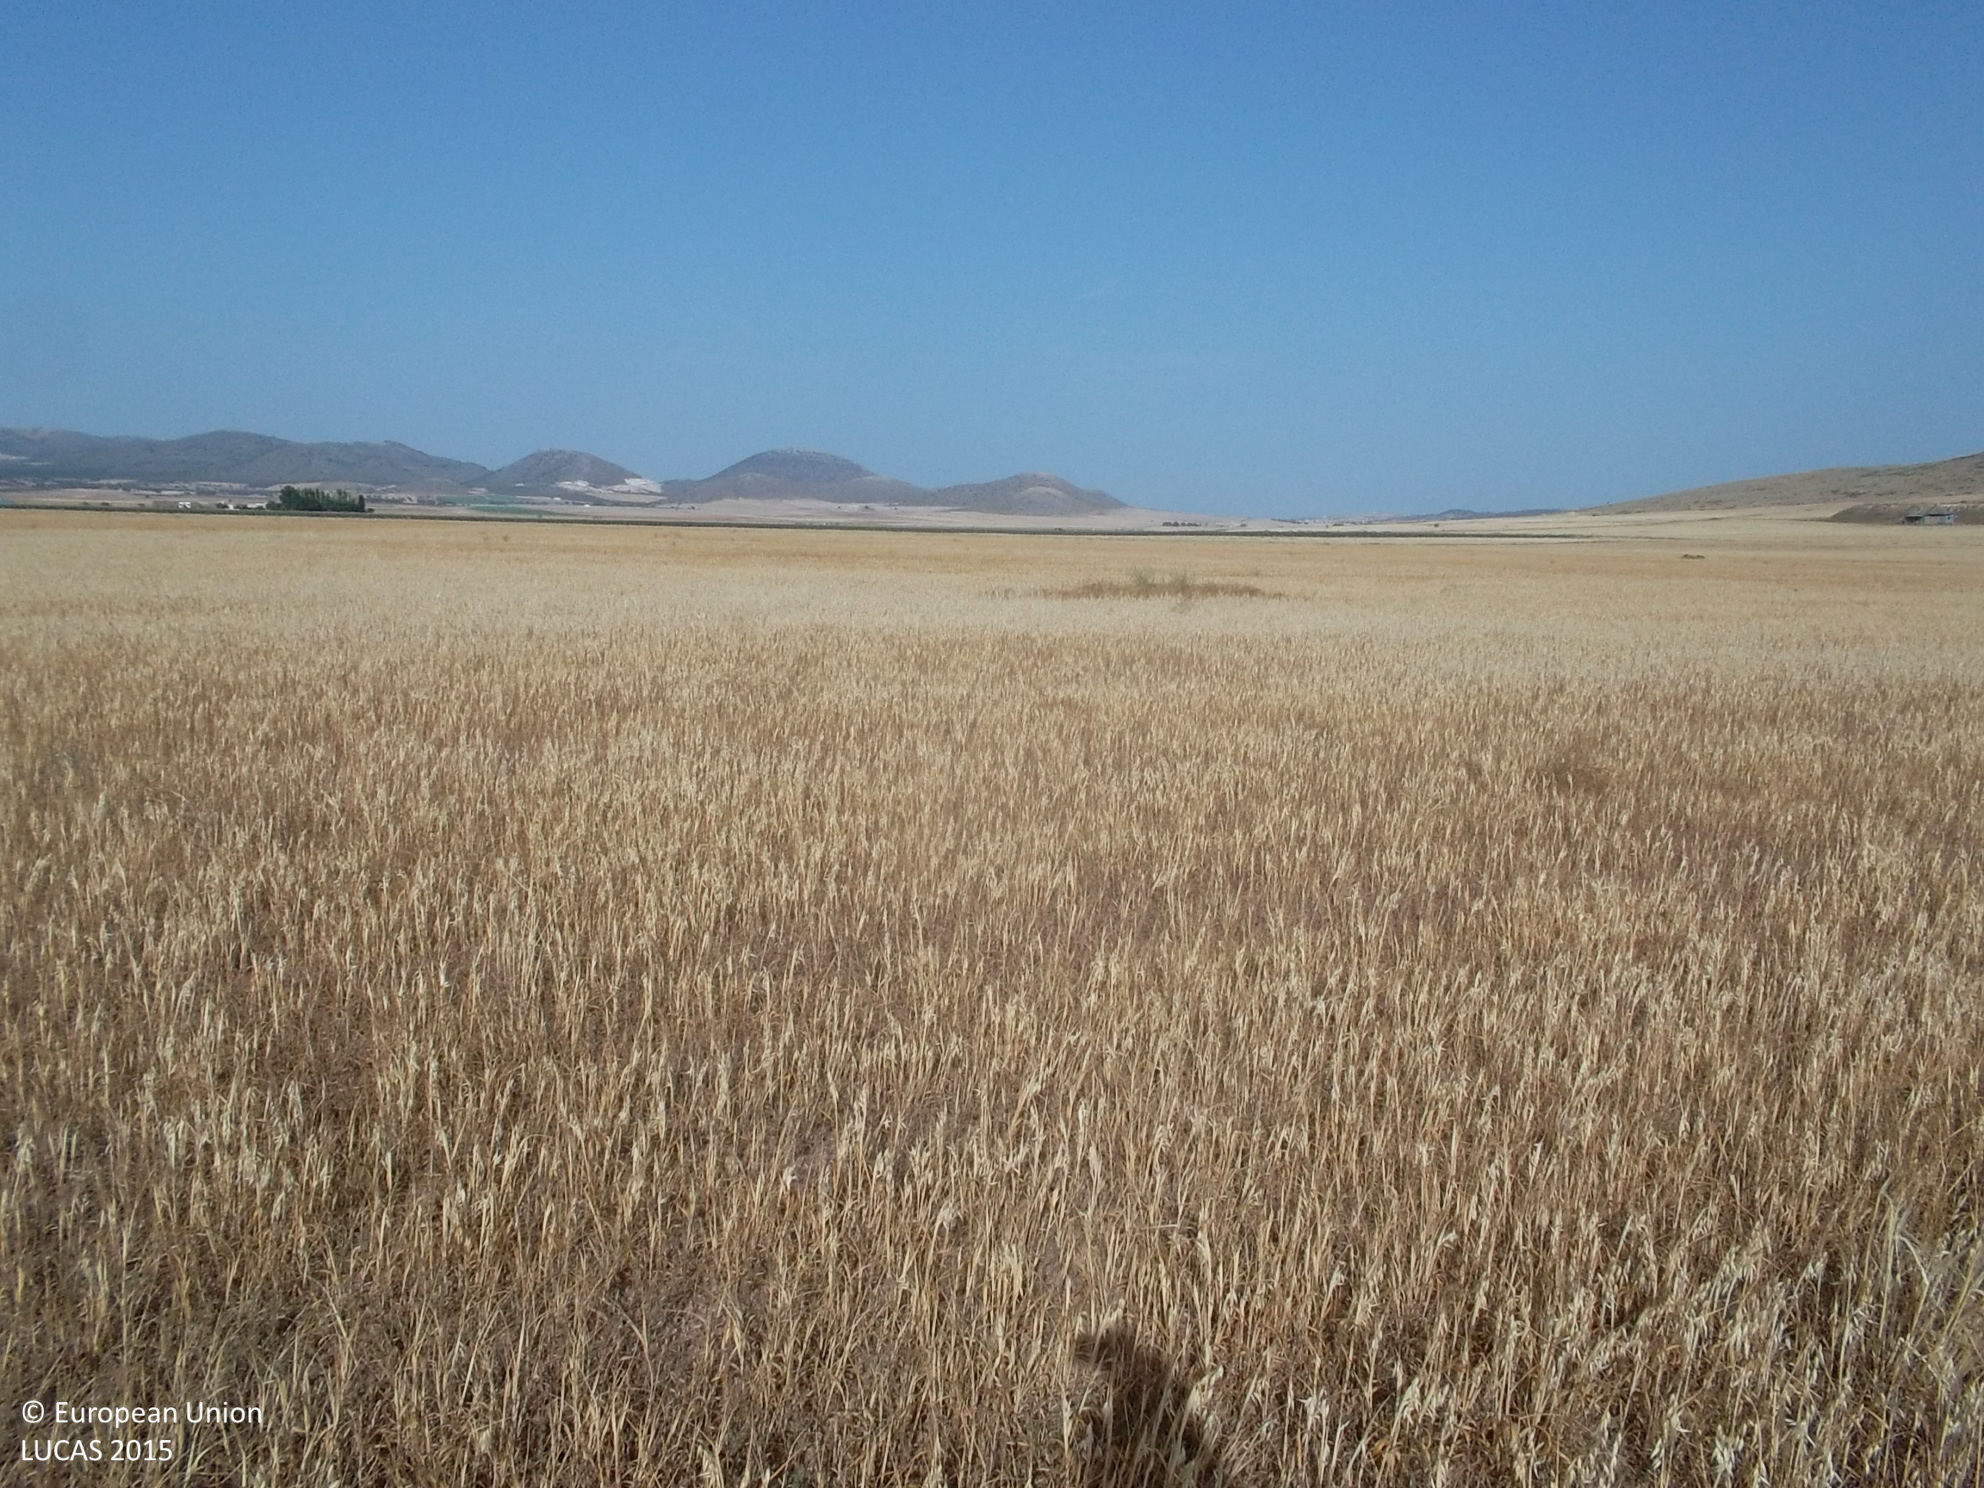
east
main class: Cropland
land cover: Oats
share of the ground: > 75 %
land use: Agriculture (excluding fallow land and kitchen gardens)
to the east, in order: Oats
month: July
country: ES
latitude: 37.8918
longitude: -2.3502
